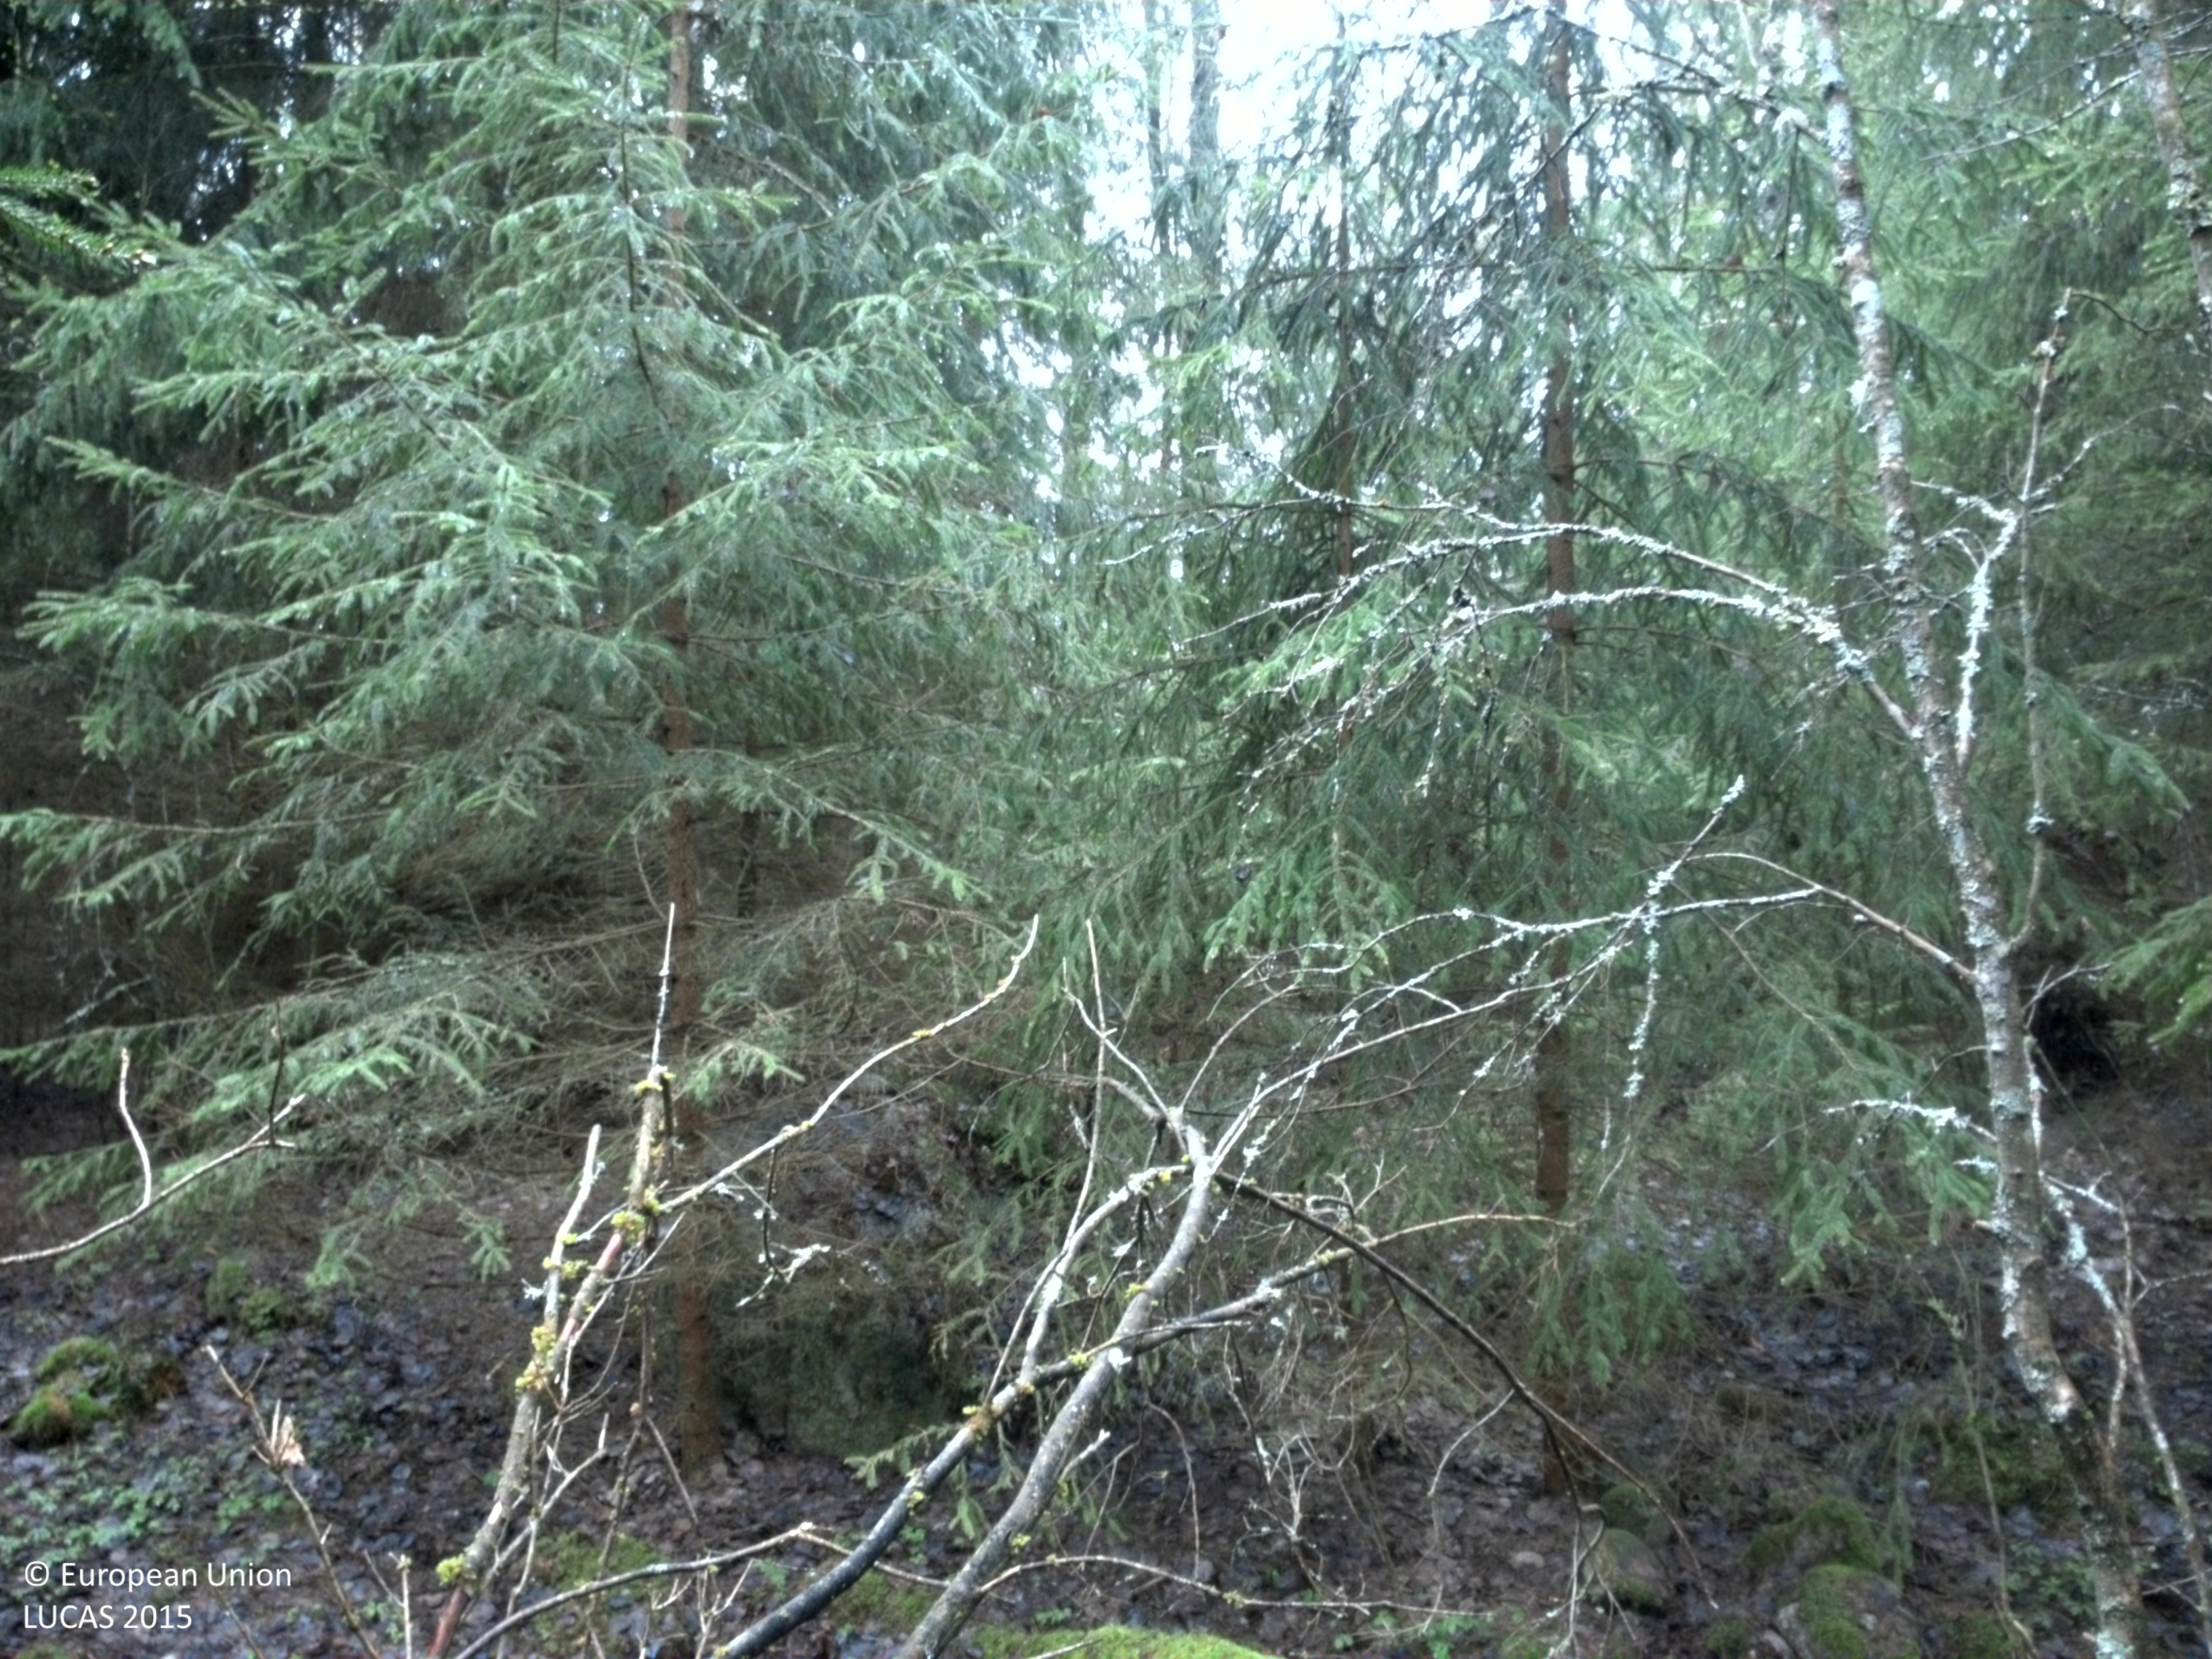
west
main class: Woodland
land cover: Spruce dominated mixed woodland
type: boreal forest
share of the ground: > 75 %
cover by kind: coniferous forest trees 40 %, broadleaved forest trees 40 %, lichens and mosses 20 %
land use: Forestry
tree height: > 5 m
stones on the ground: < 10 %
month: May
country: SE
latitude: 56.6820
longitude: 15.0745
